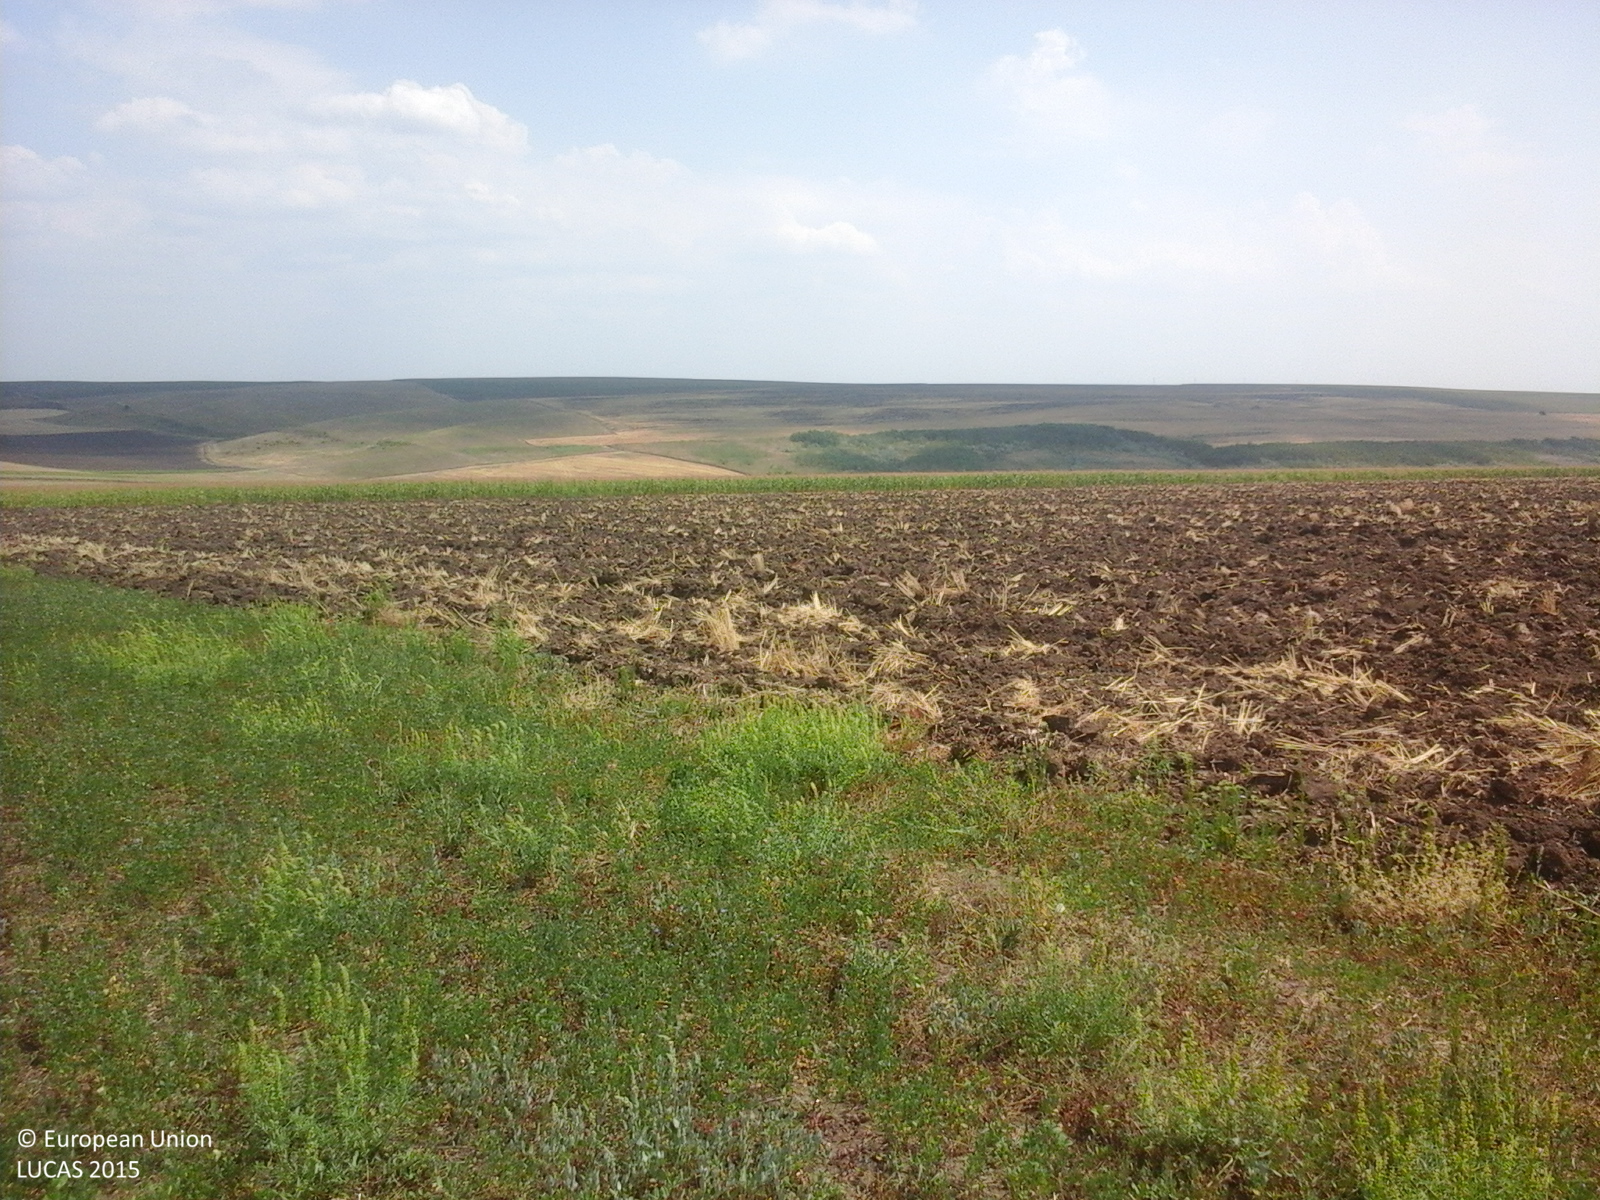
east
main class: Cropland
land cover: Lucerne
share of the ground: > 75 %
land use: Agriculture (excluding fallow land and kitchen gardens)
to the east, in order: Lucerne; Common wheat; Tracks; Grass margins; Maize
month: July
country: RO
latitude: 46.2399
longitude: 28.0350
